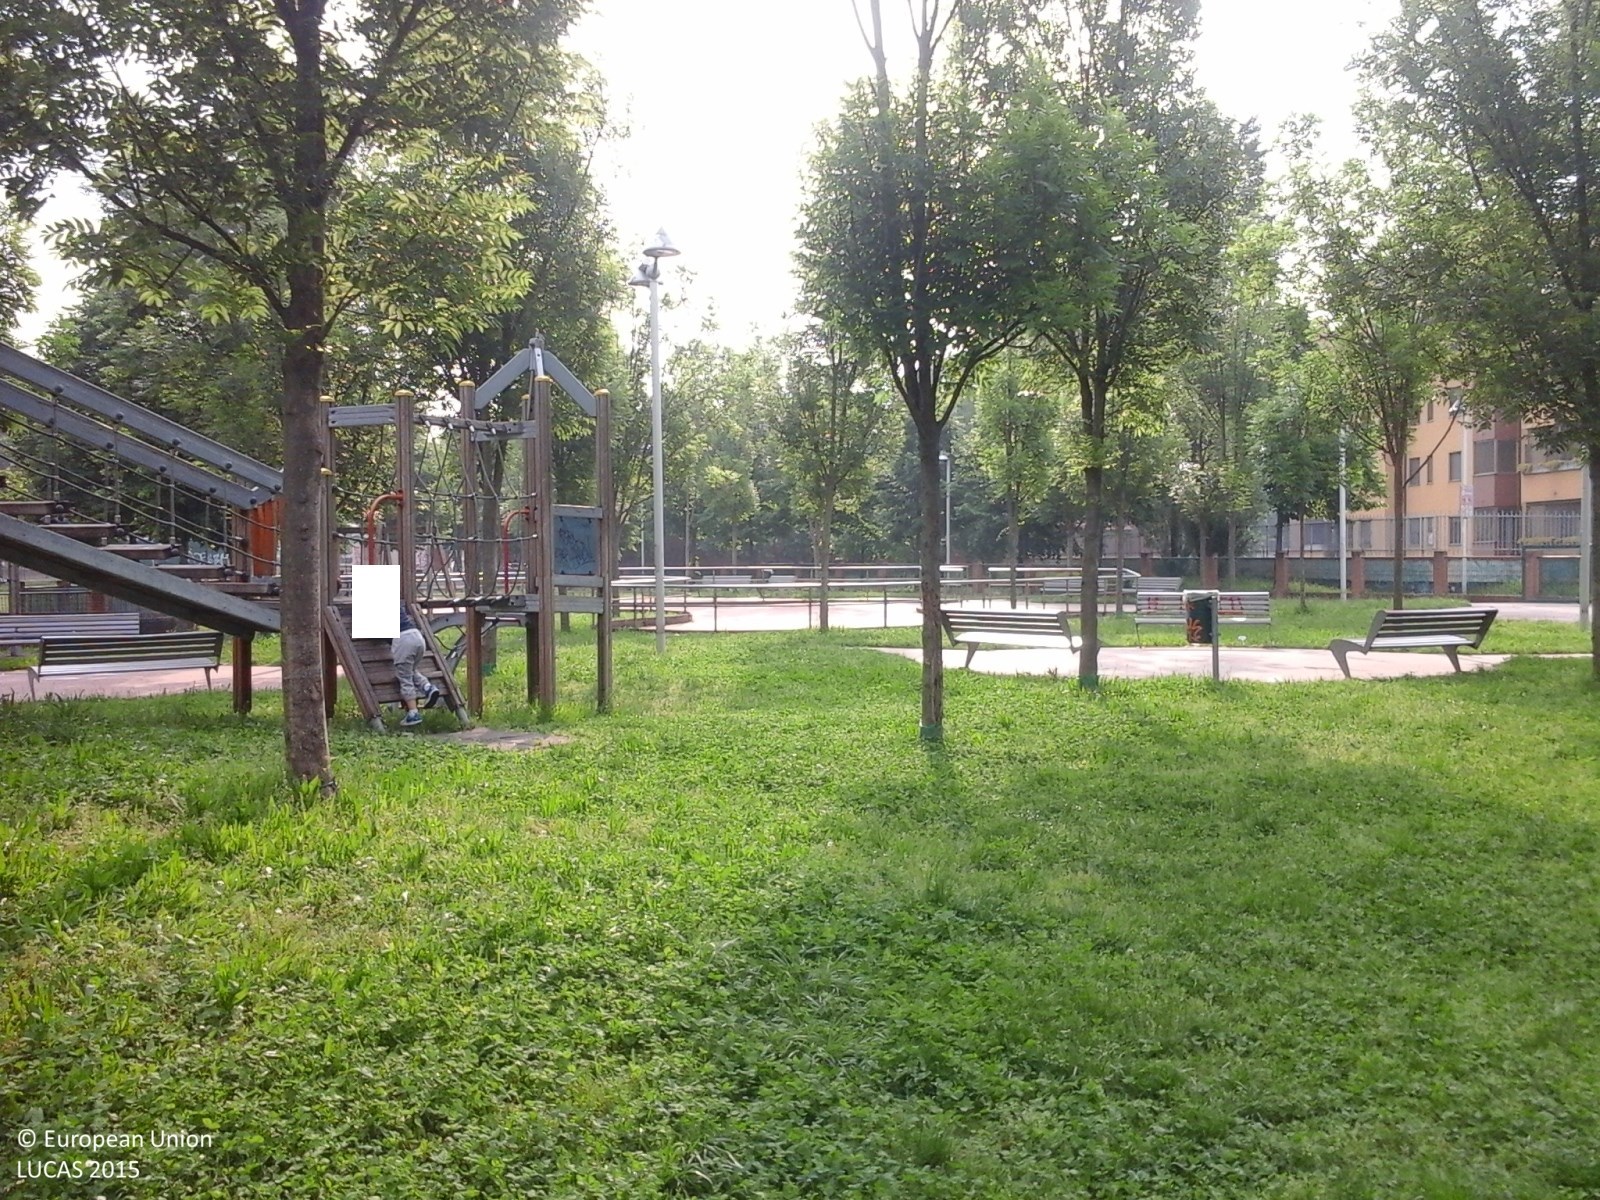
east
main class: Woodland
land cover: Broadleaved woodland
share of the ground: > 75 %
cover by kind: broadleaved forest trees 60 %, herbaceous plants 30 %, consolidated bare surface 10 %
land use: Amenities, museums, leisure
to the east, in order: Broadleaved woodland; Artificial constructions in urban areas
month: May
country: IT
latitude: 45.3930
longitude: 9.1712
